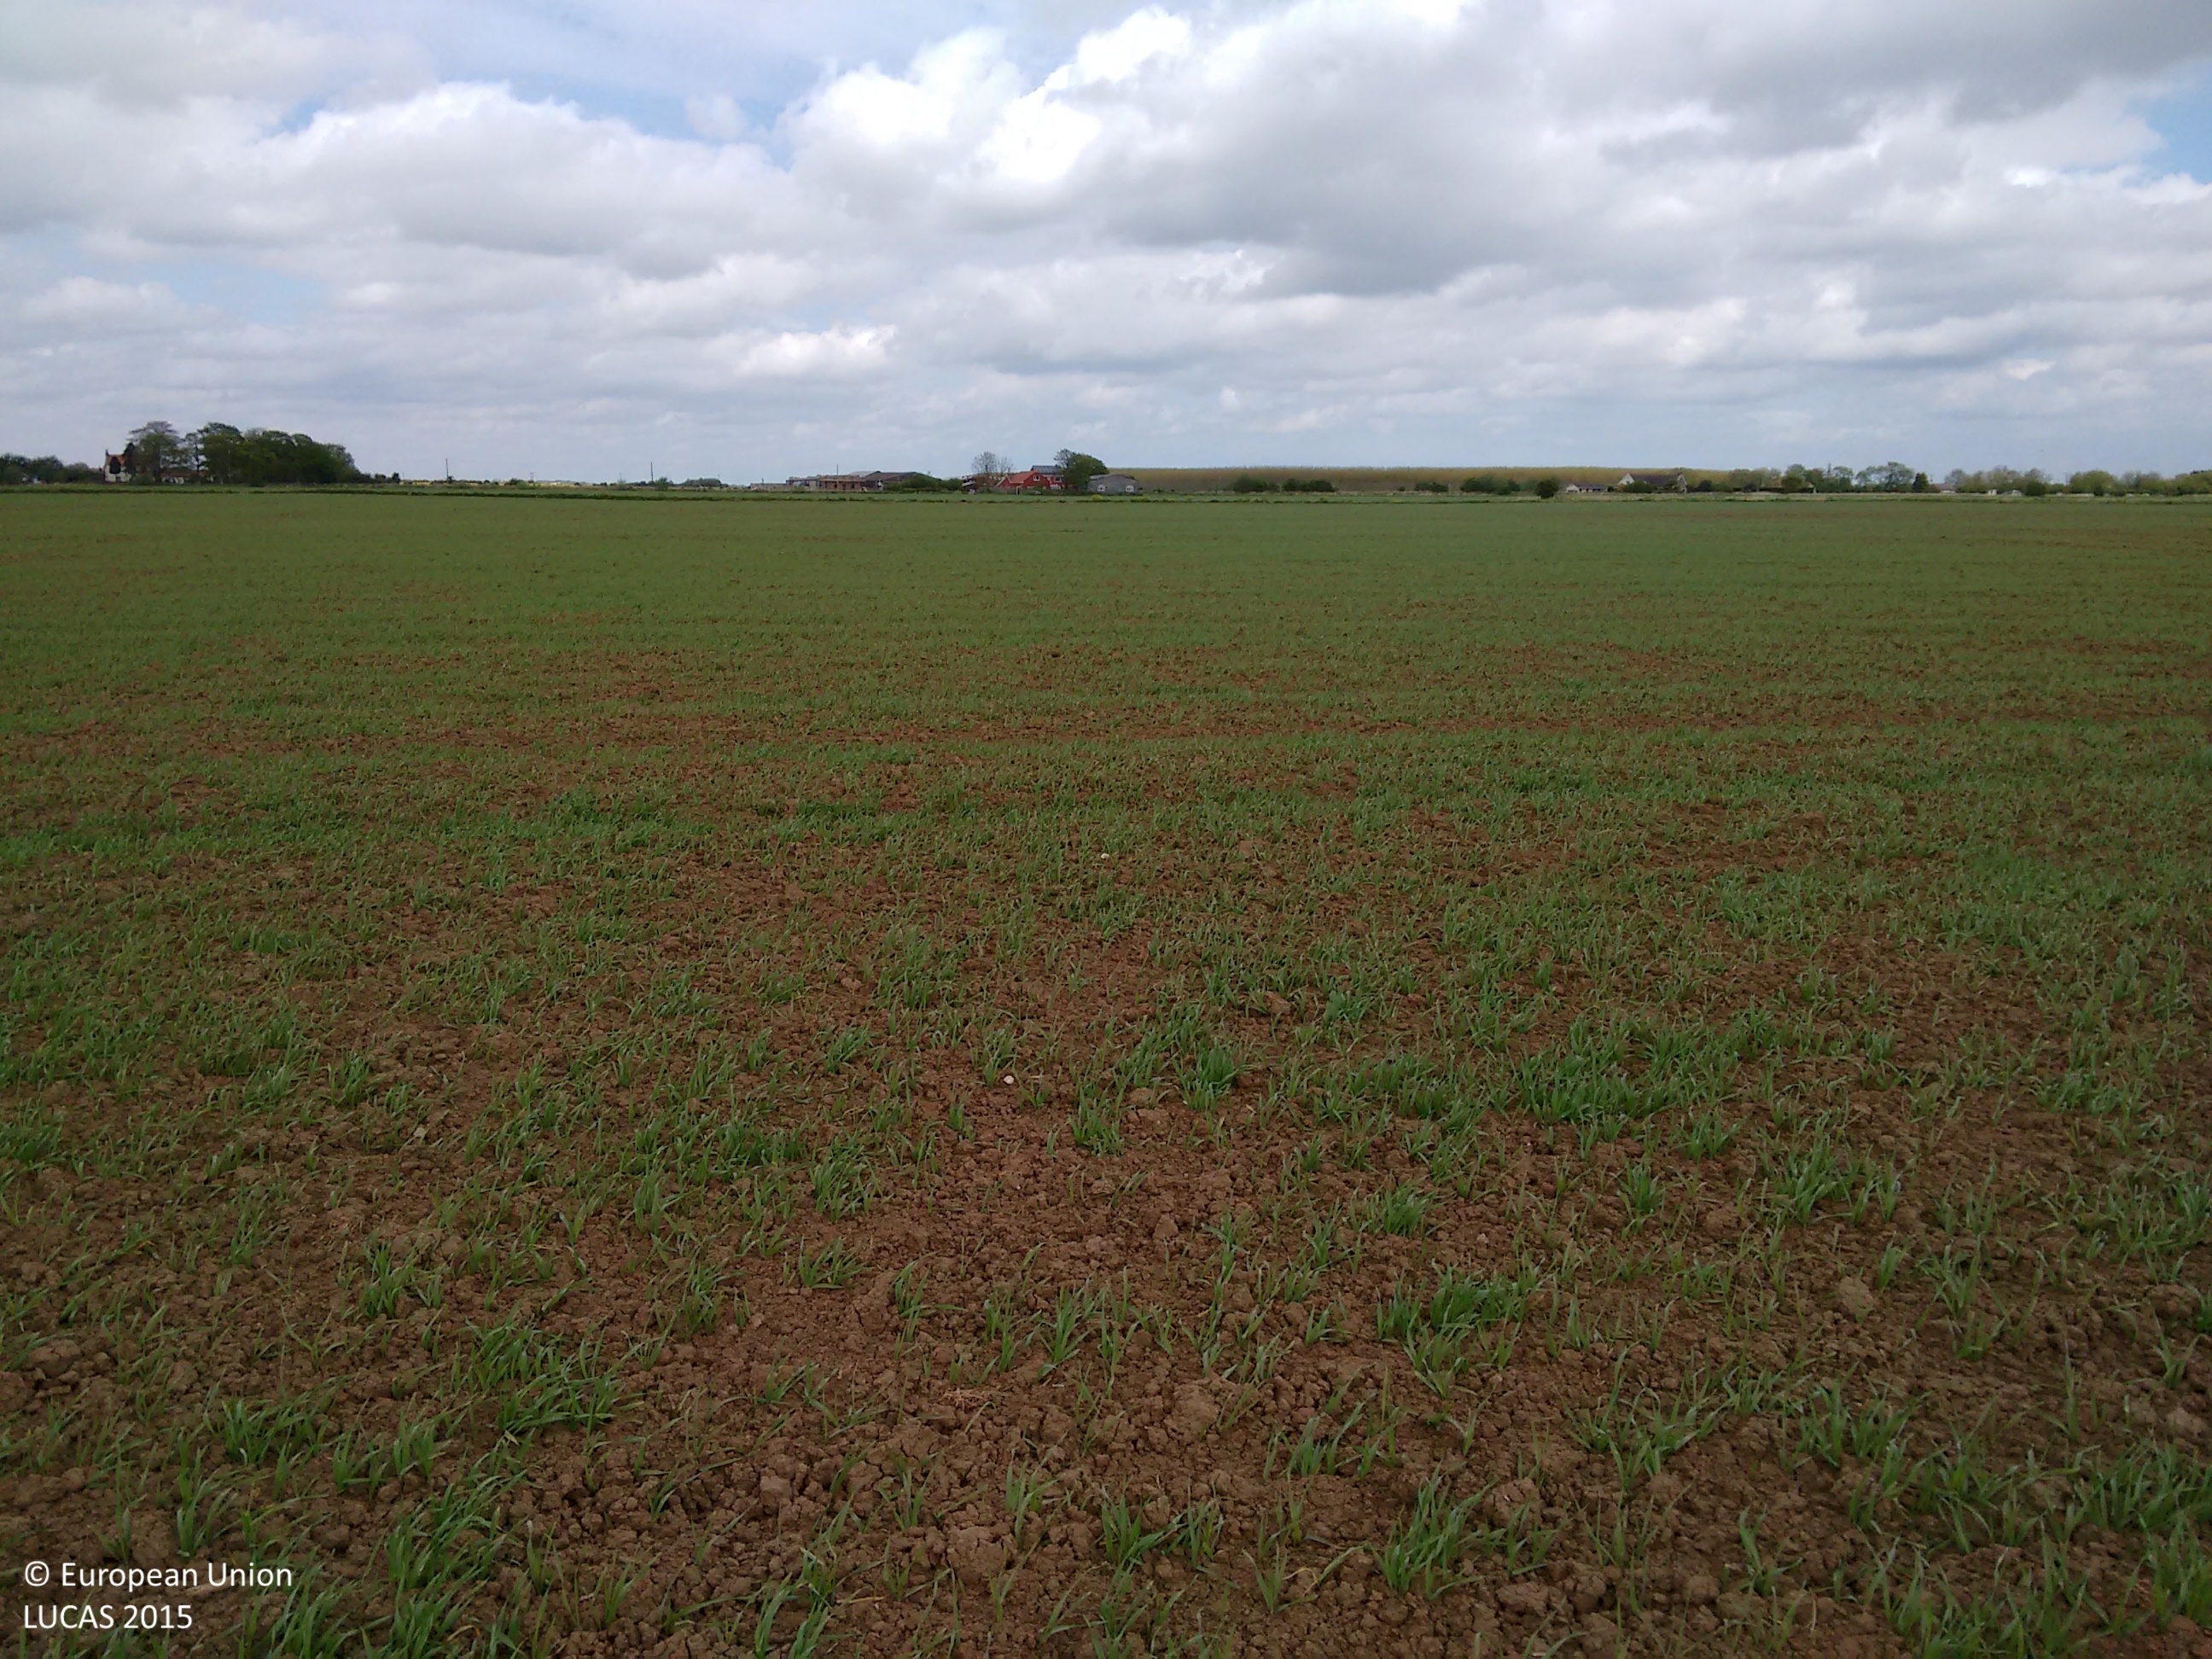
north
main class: Cropland
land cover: Barley
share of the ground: 10 - 25 %
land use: Agriculture (excluding fallow land and kitchen gardens)
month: May
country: GB
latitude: 53.1740
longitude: 0.2913
